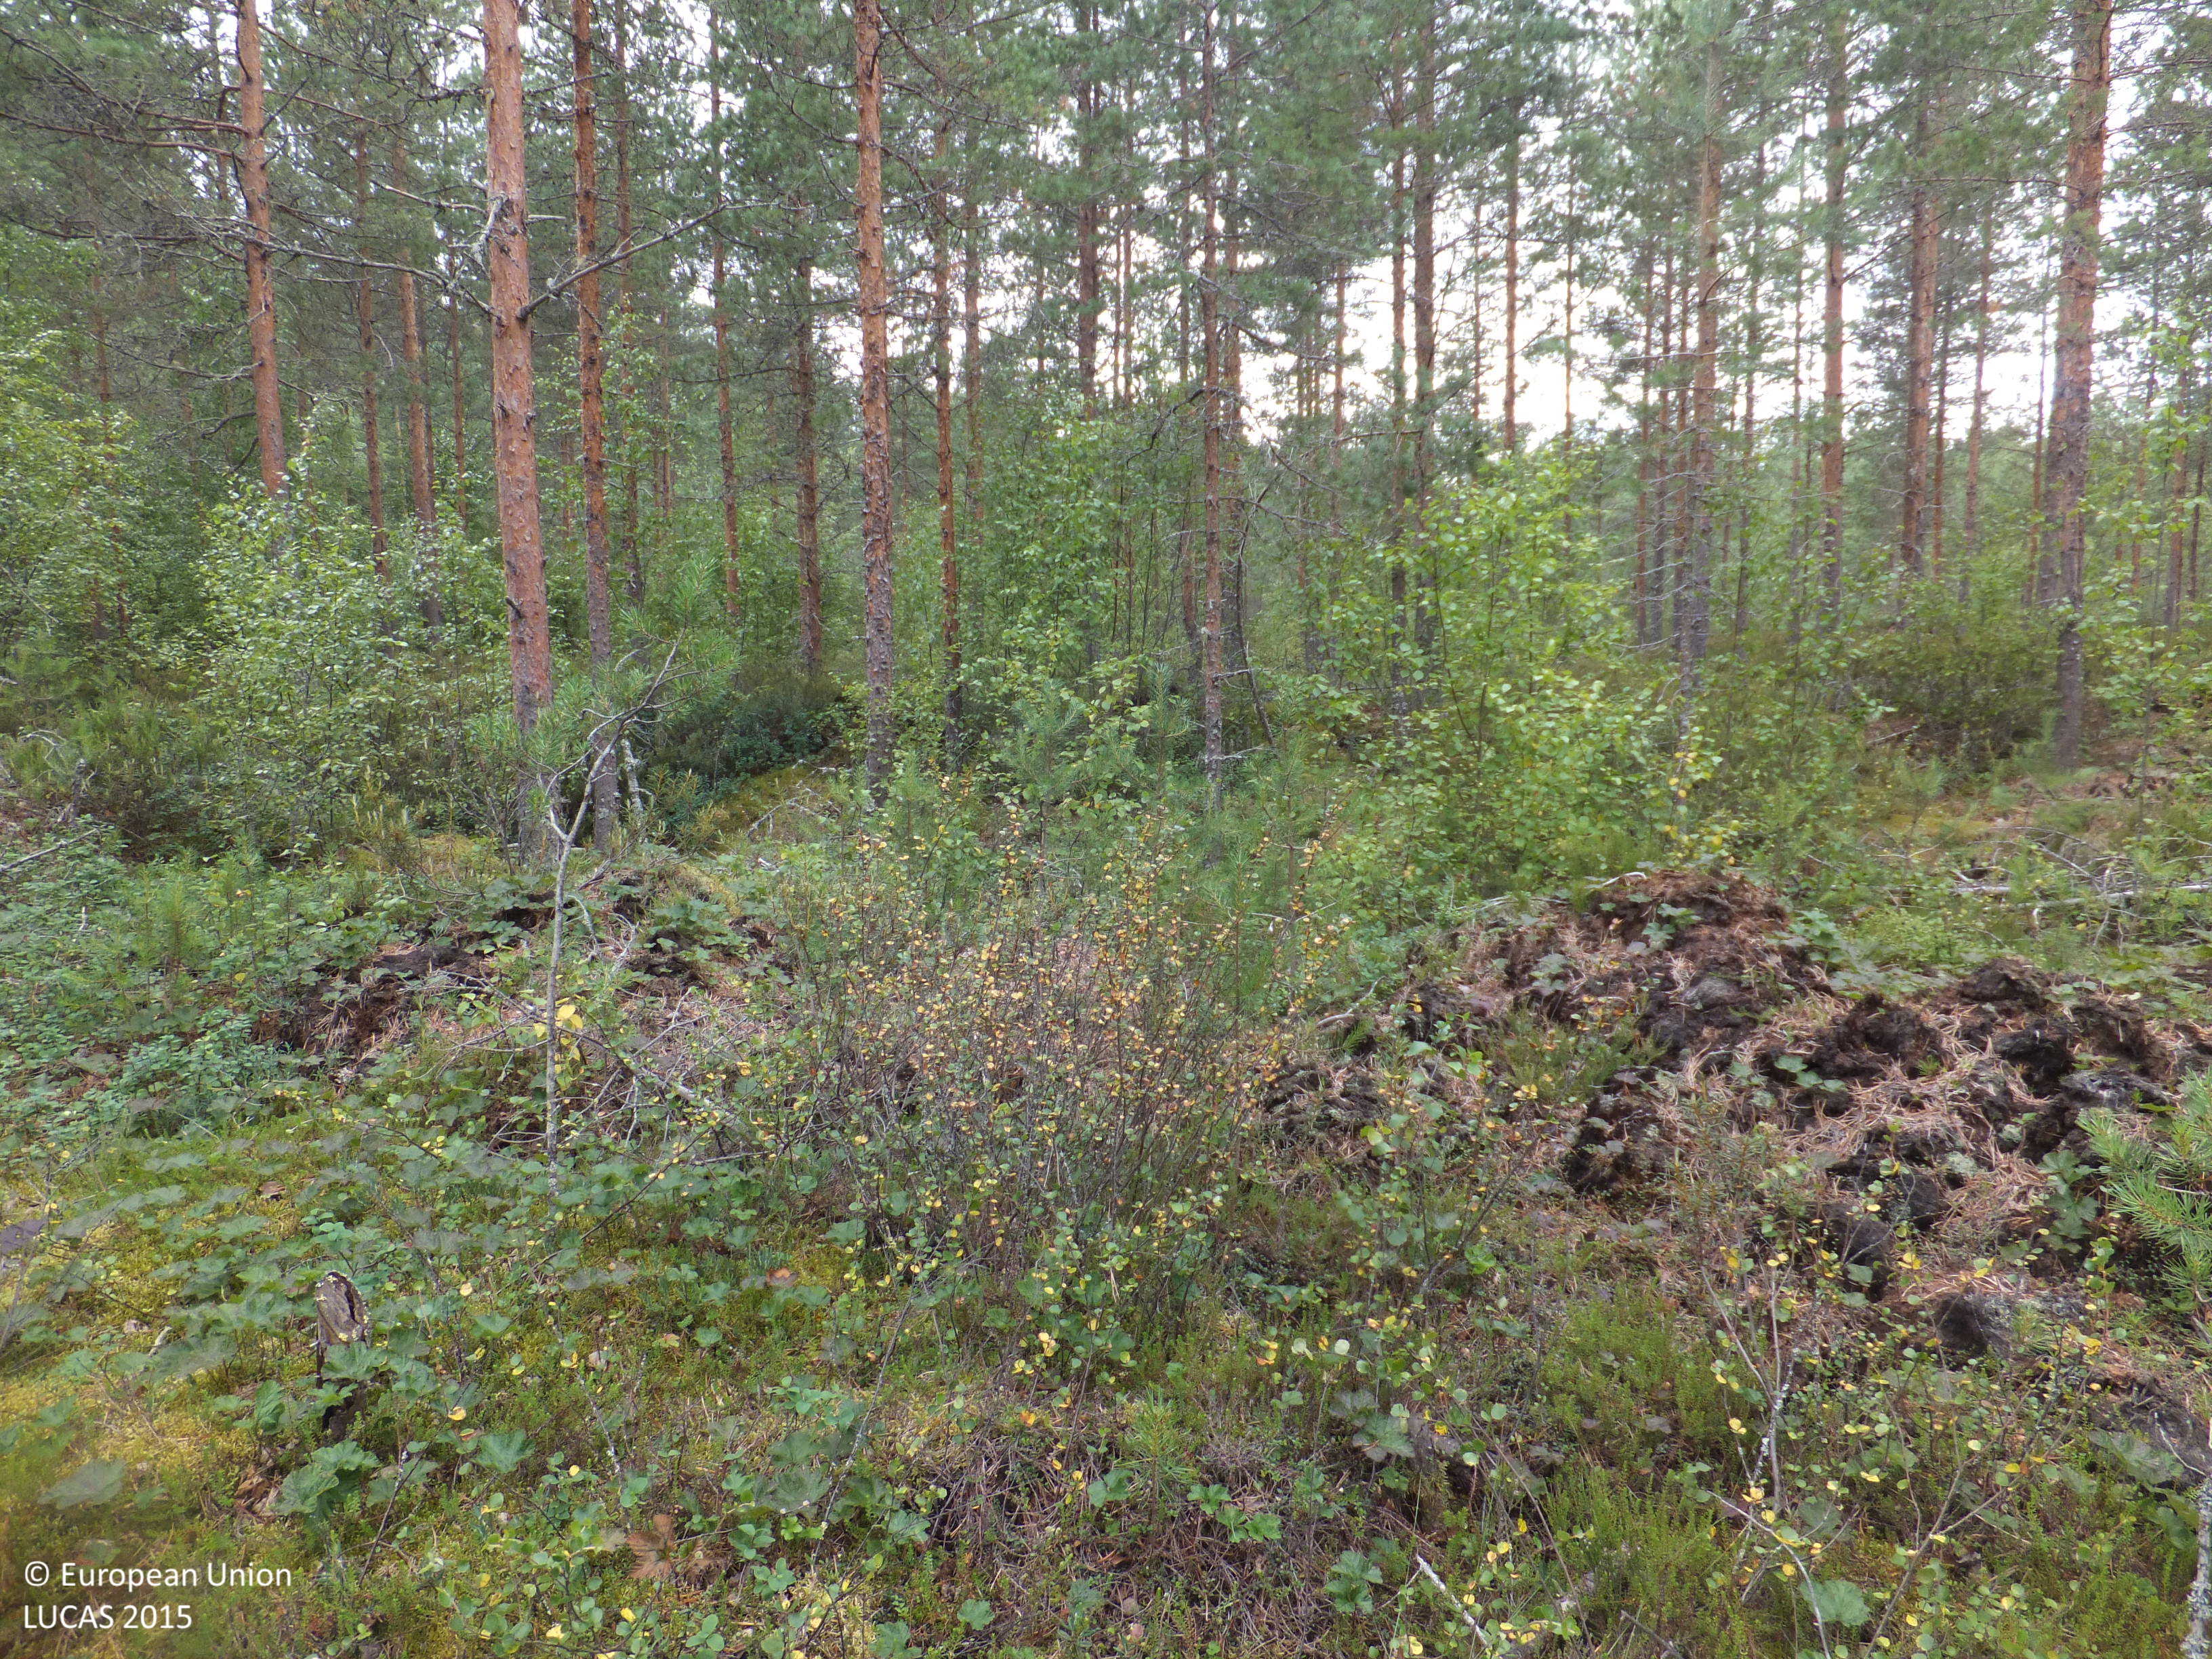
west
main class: Woodland
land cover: Pine dominated coniferous woodland
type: mire and swamp forests
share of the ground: 50 - 75 %
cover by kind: coniferous forest trees 45 %, shrubs 20 %, lichens and mosses 15 %, unconsolidated bare surface 10 %, broadleaved forest trees 5 %, herbaceous plants 5 %
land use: Forestry
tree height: > 5 m
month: July
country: FI
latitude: 63.0128
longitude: 22.3953
